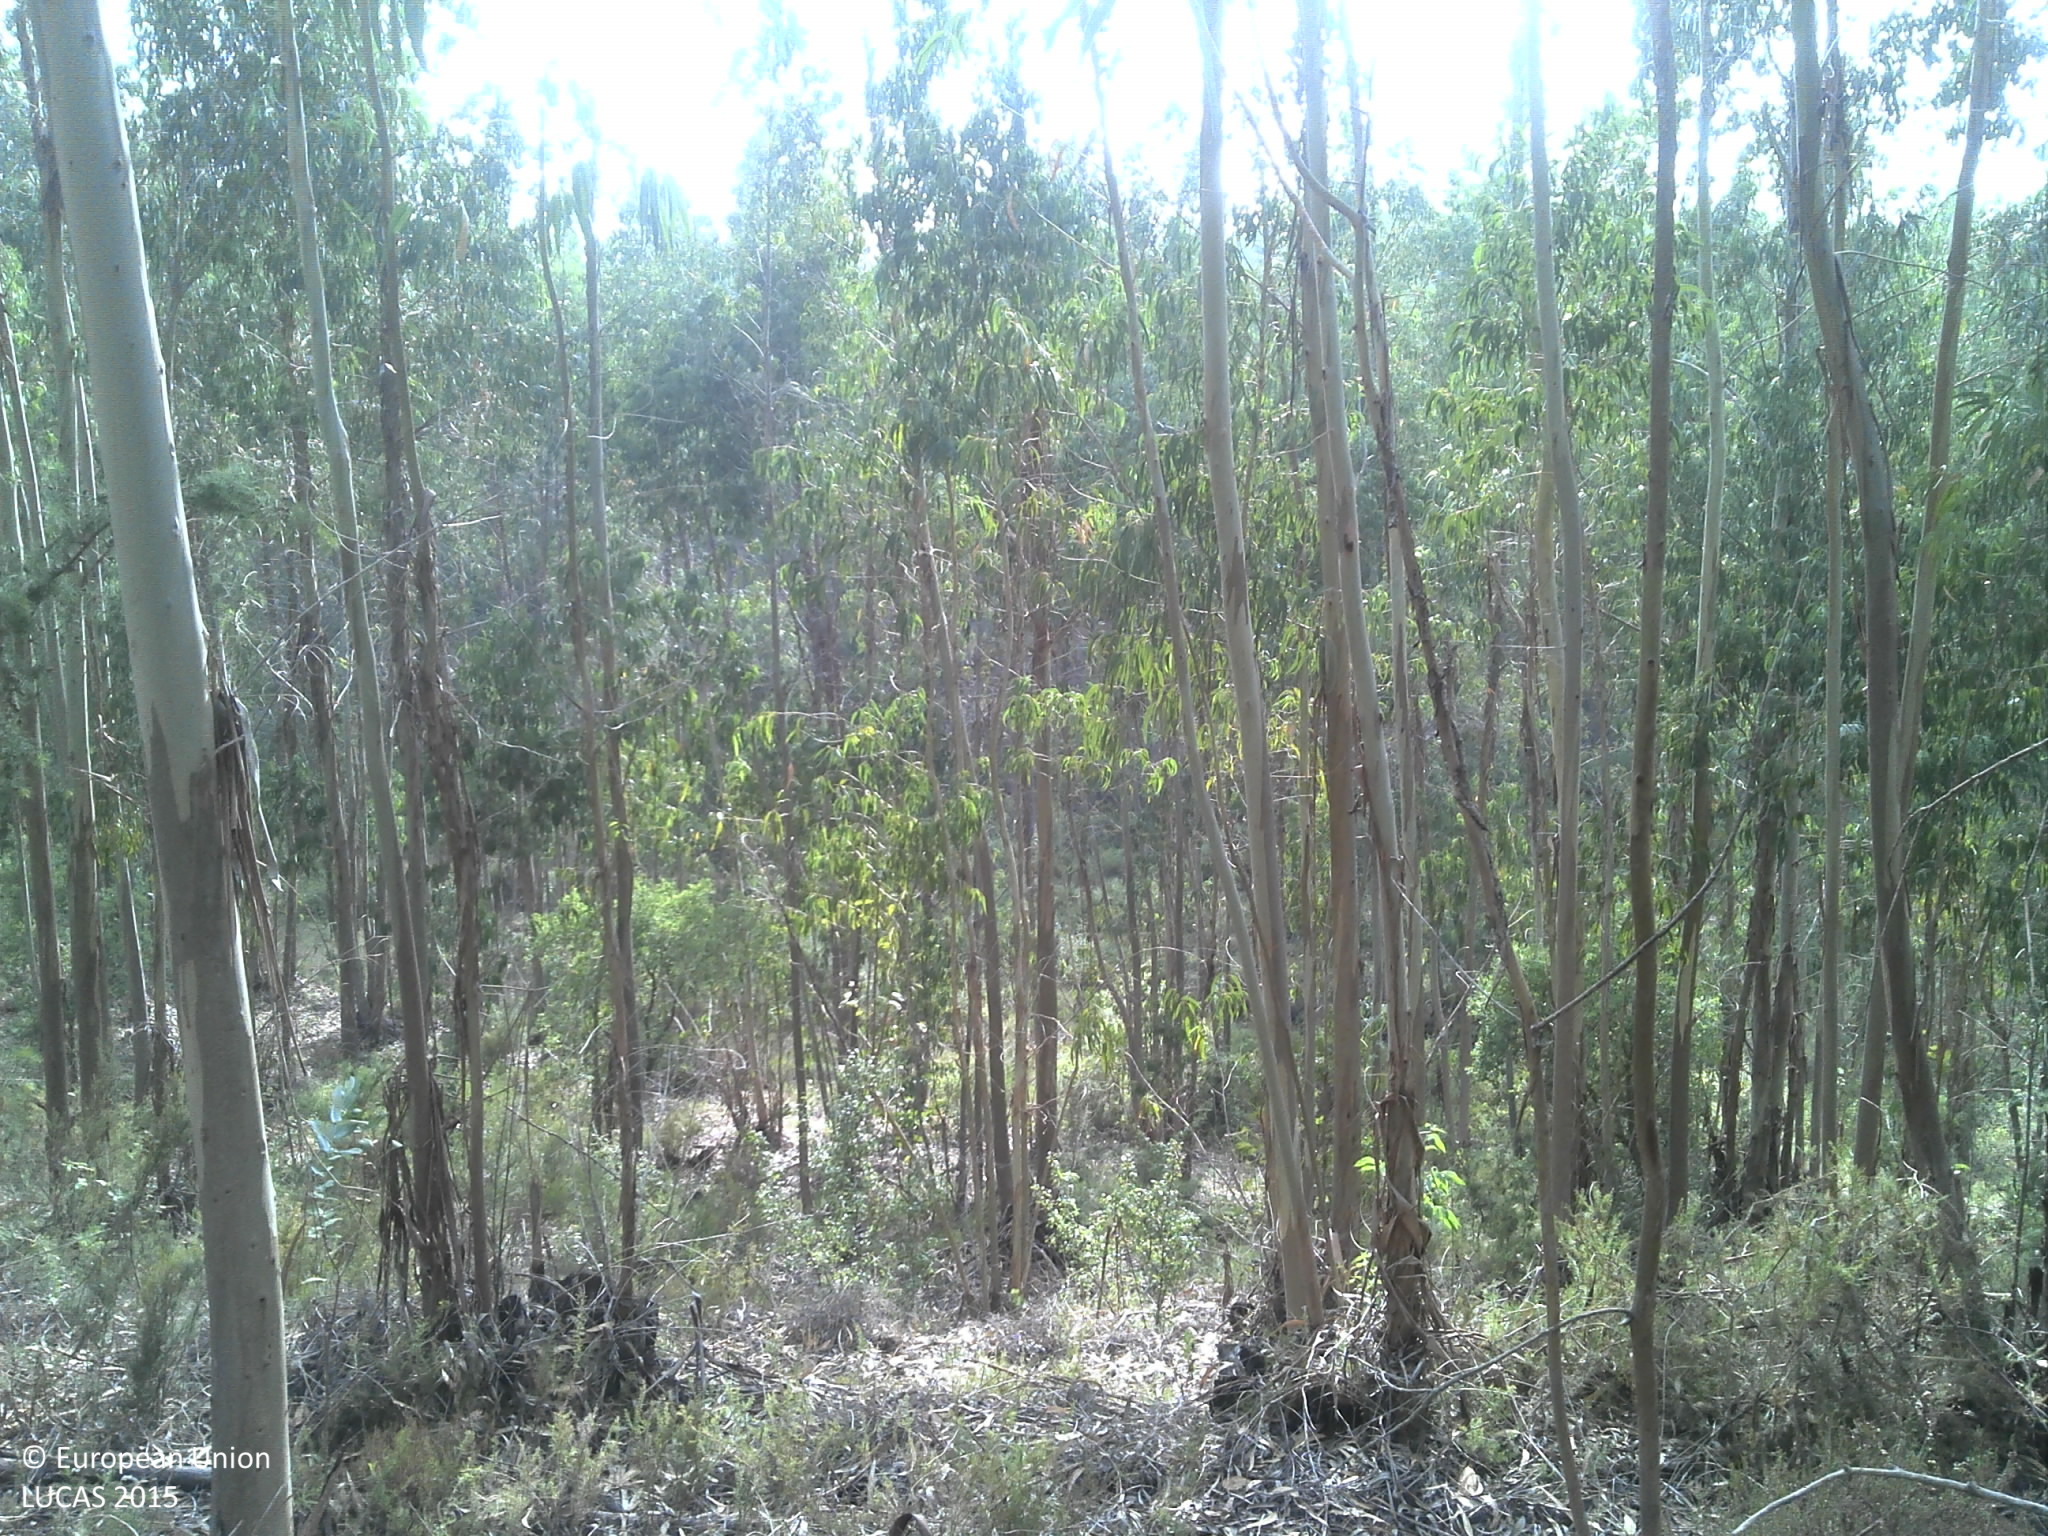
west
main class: Woodland
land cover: Broadleaved woodland
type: exotic forest
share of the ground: 50 - 75 %
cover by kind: broadleaved forest trees 70 %, shrubs 15 %, unconsolidated bare surface 15 %
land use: Forestry
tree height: > 5 m
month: June
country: PT
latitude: 39.3709
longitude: -8.2524
